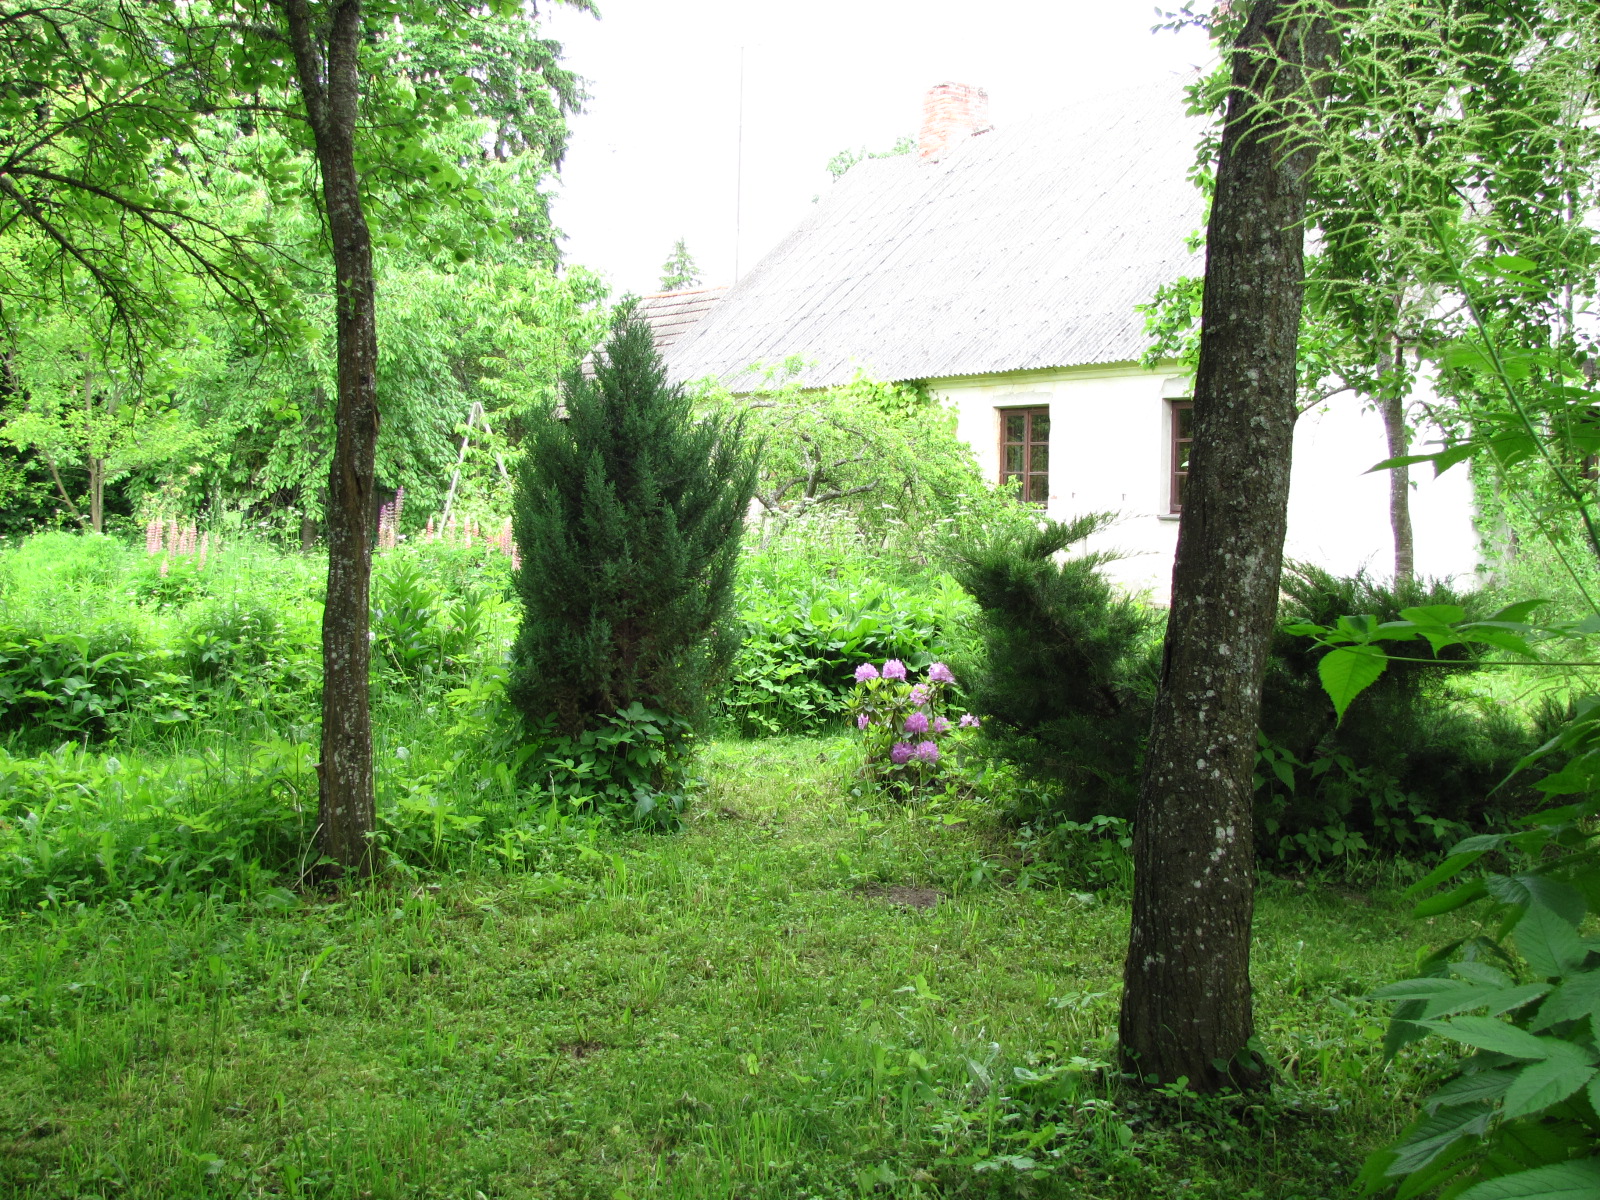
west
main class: Woodland
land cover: Broadleaved woodland
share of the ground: > 75 %
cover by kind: broadleaved forest trees 80 %, herbaceous plants 20 %
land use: Residential
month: June
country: LV
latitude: 56.3562
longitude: 24.0868
